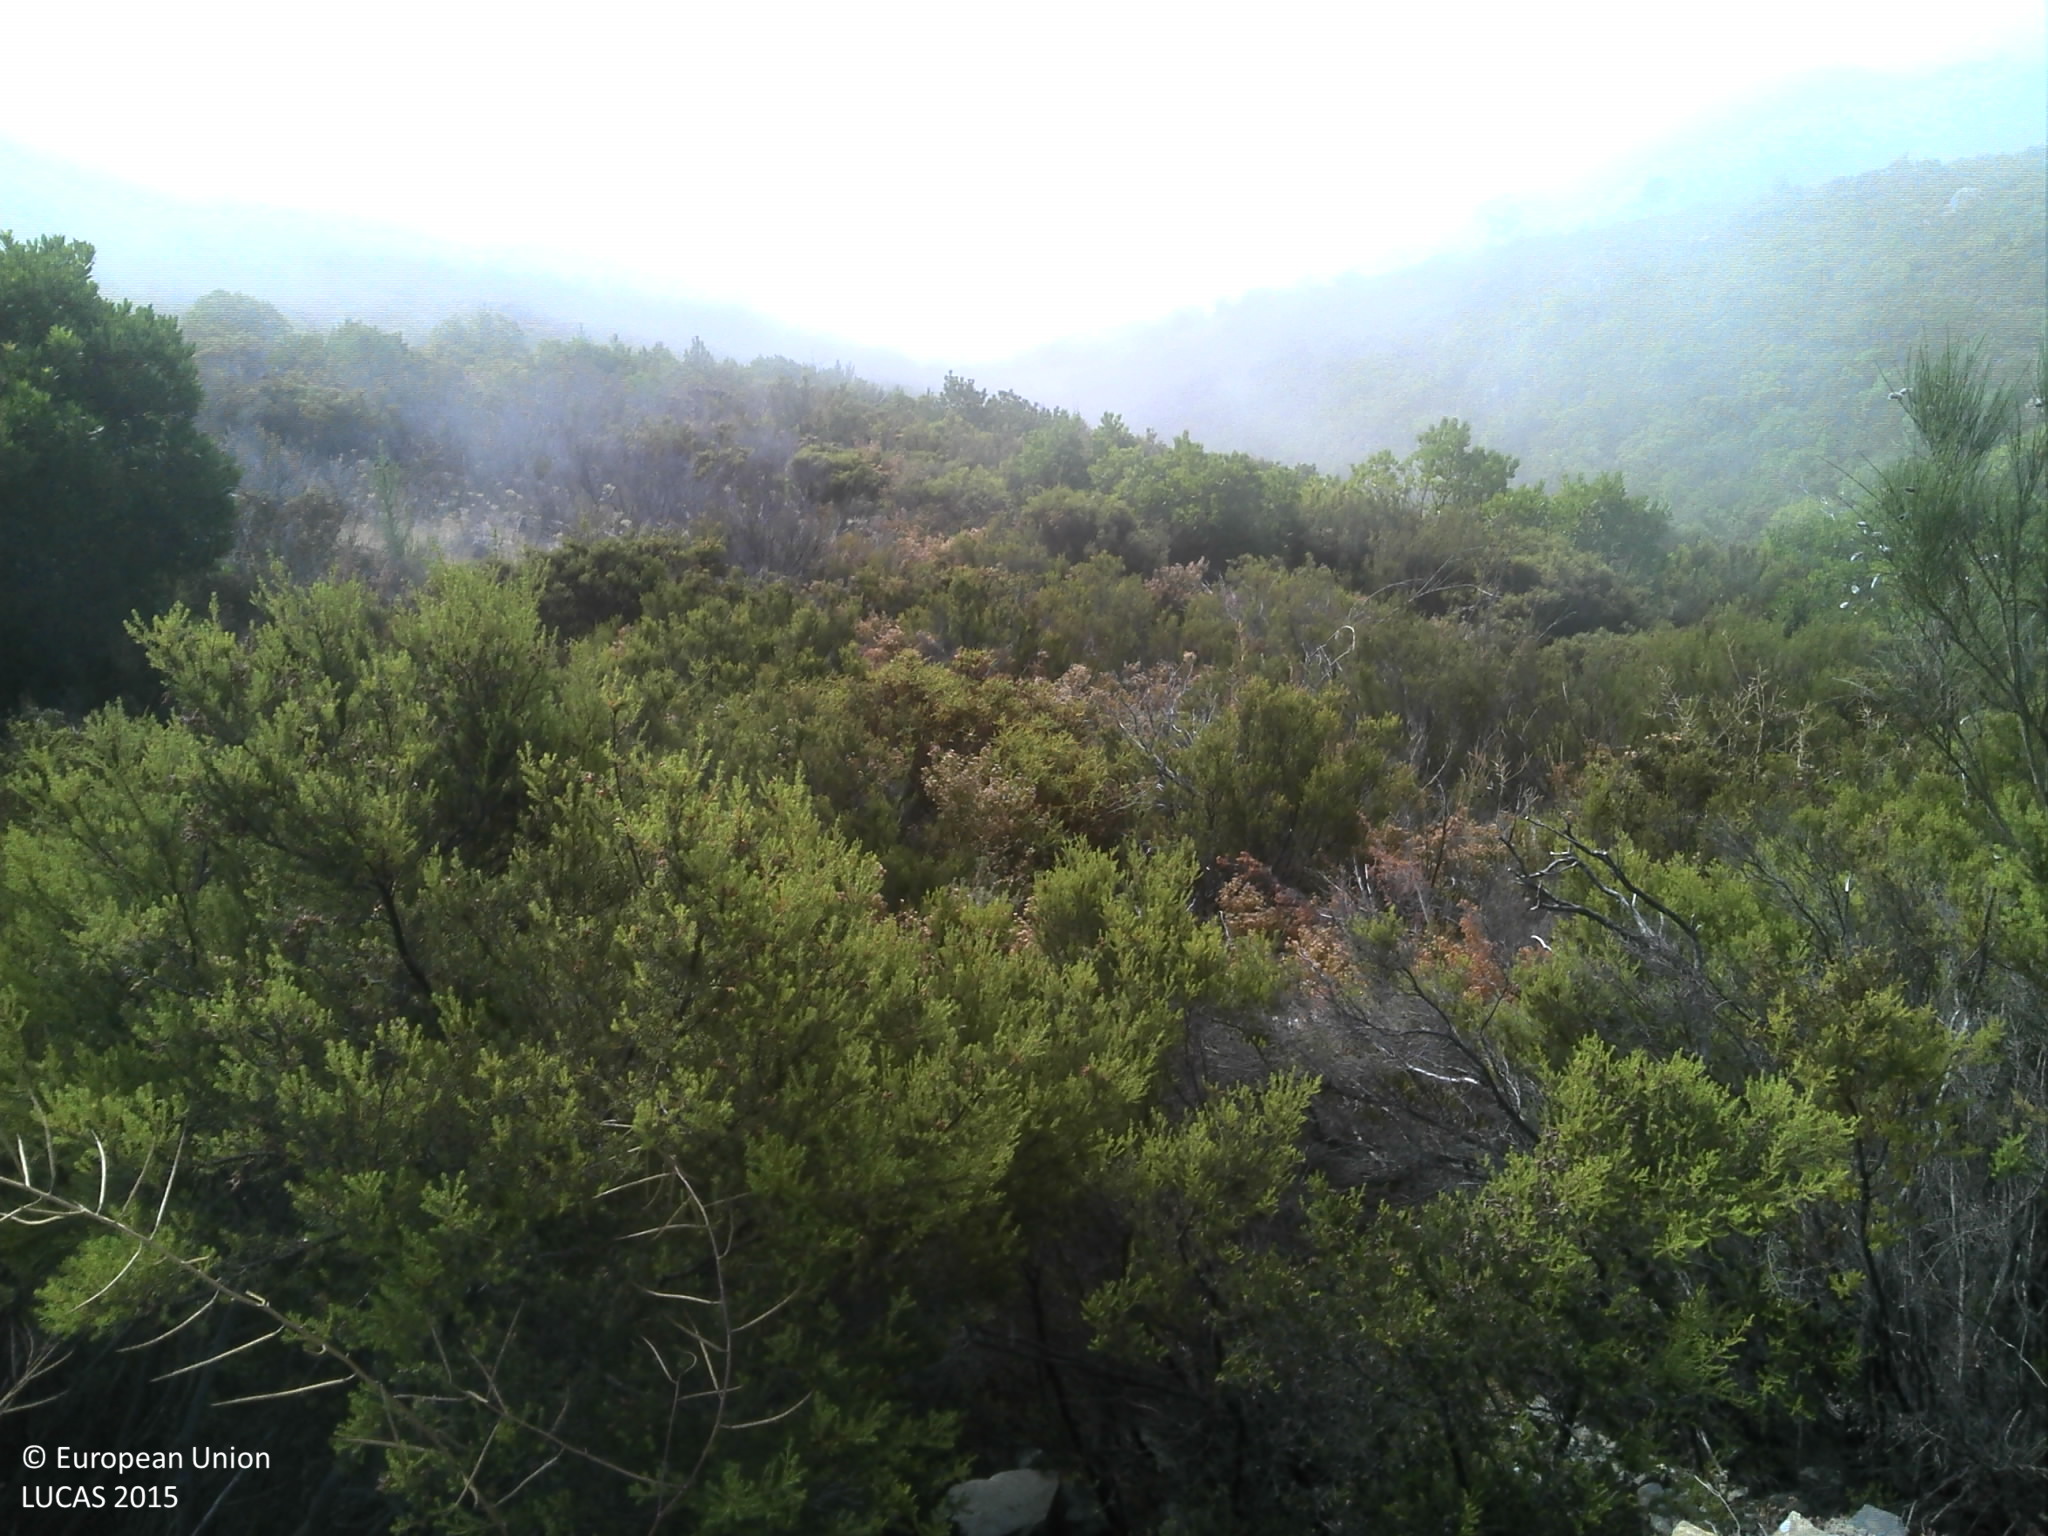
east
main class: Shrubland
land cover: Shrubland without tree cover
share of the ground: 50 - 75 %
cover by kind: shrubs 75 %, unconsolidated bare surface 25 %
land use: Semi-natural and natural areas not in use
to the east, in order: Shrubland without tree cover; Pine dominated coniferous woodland; Tracks; Grass margins; Tracks; Pine dominated coniferous woodland; Tracks; Pine dominated coniferous woodland
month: July
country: PT
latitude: 40.2445
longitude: -7.8303
